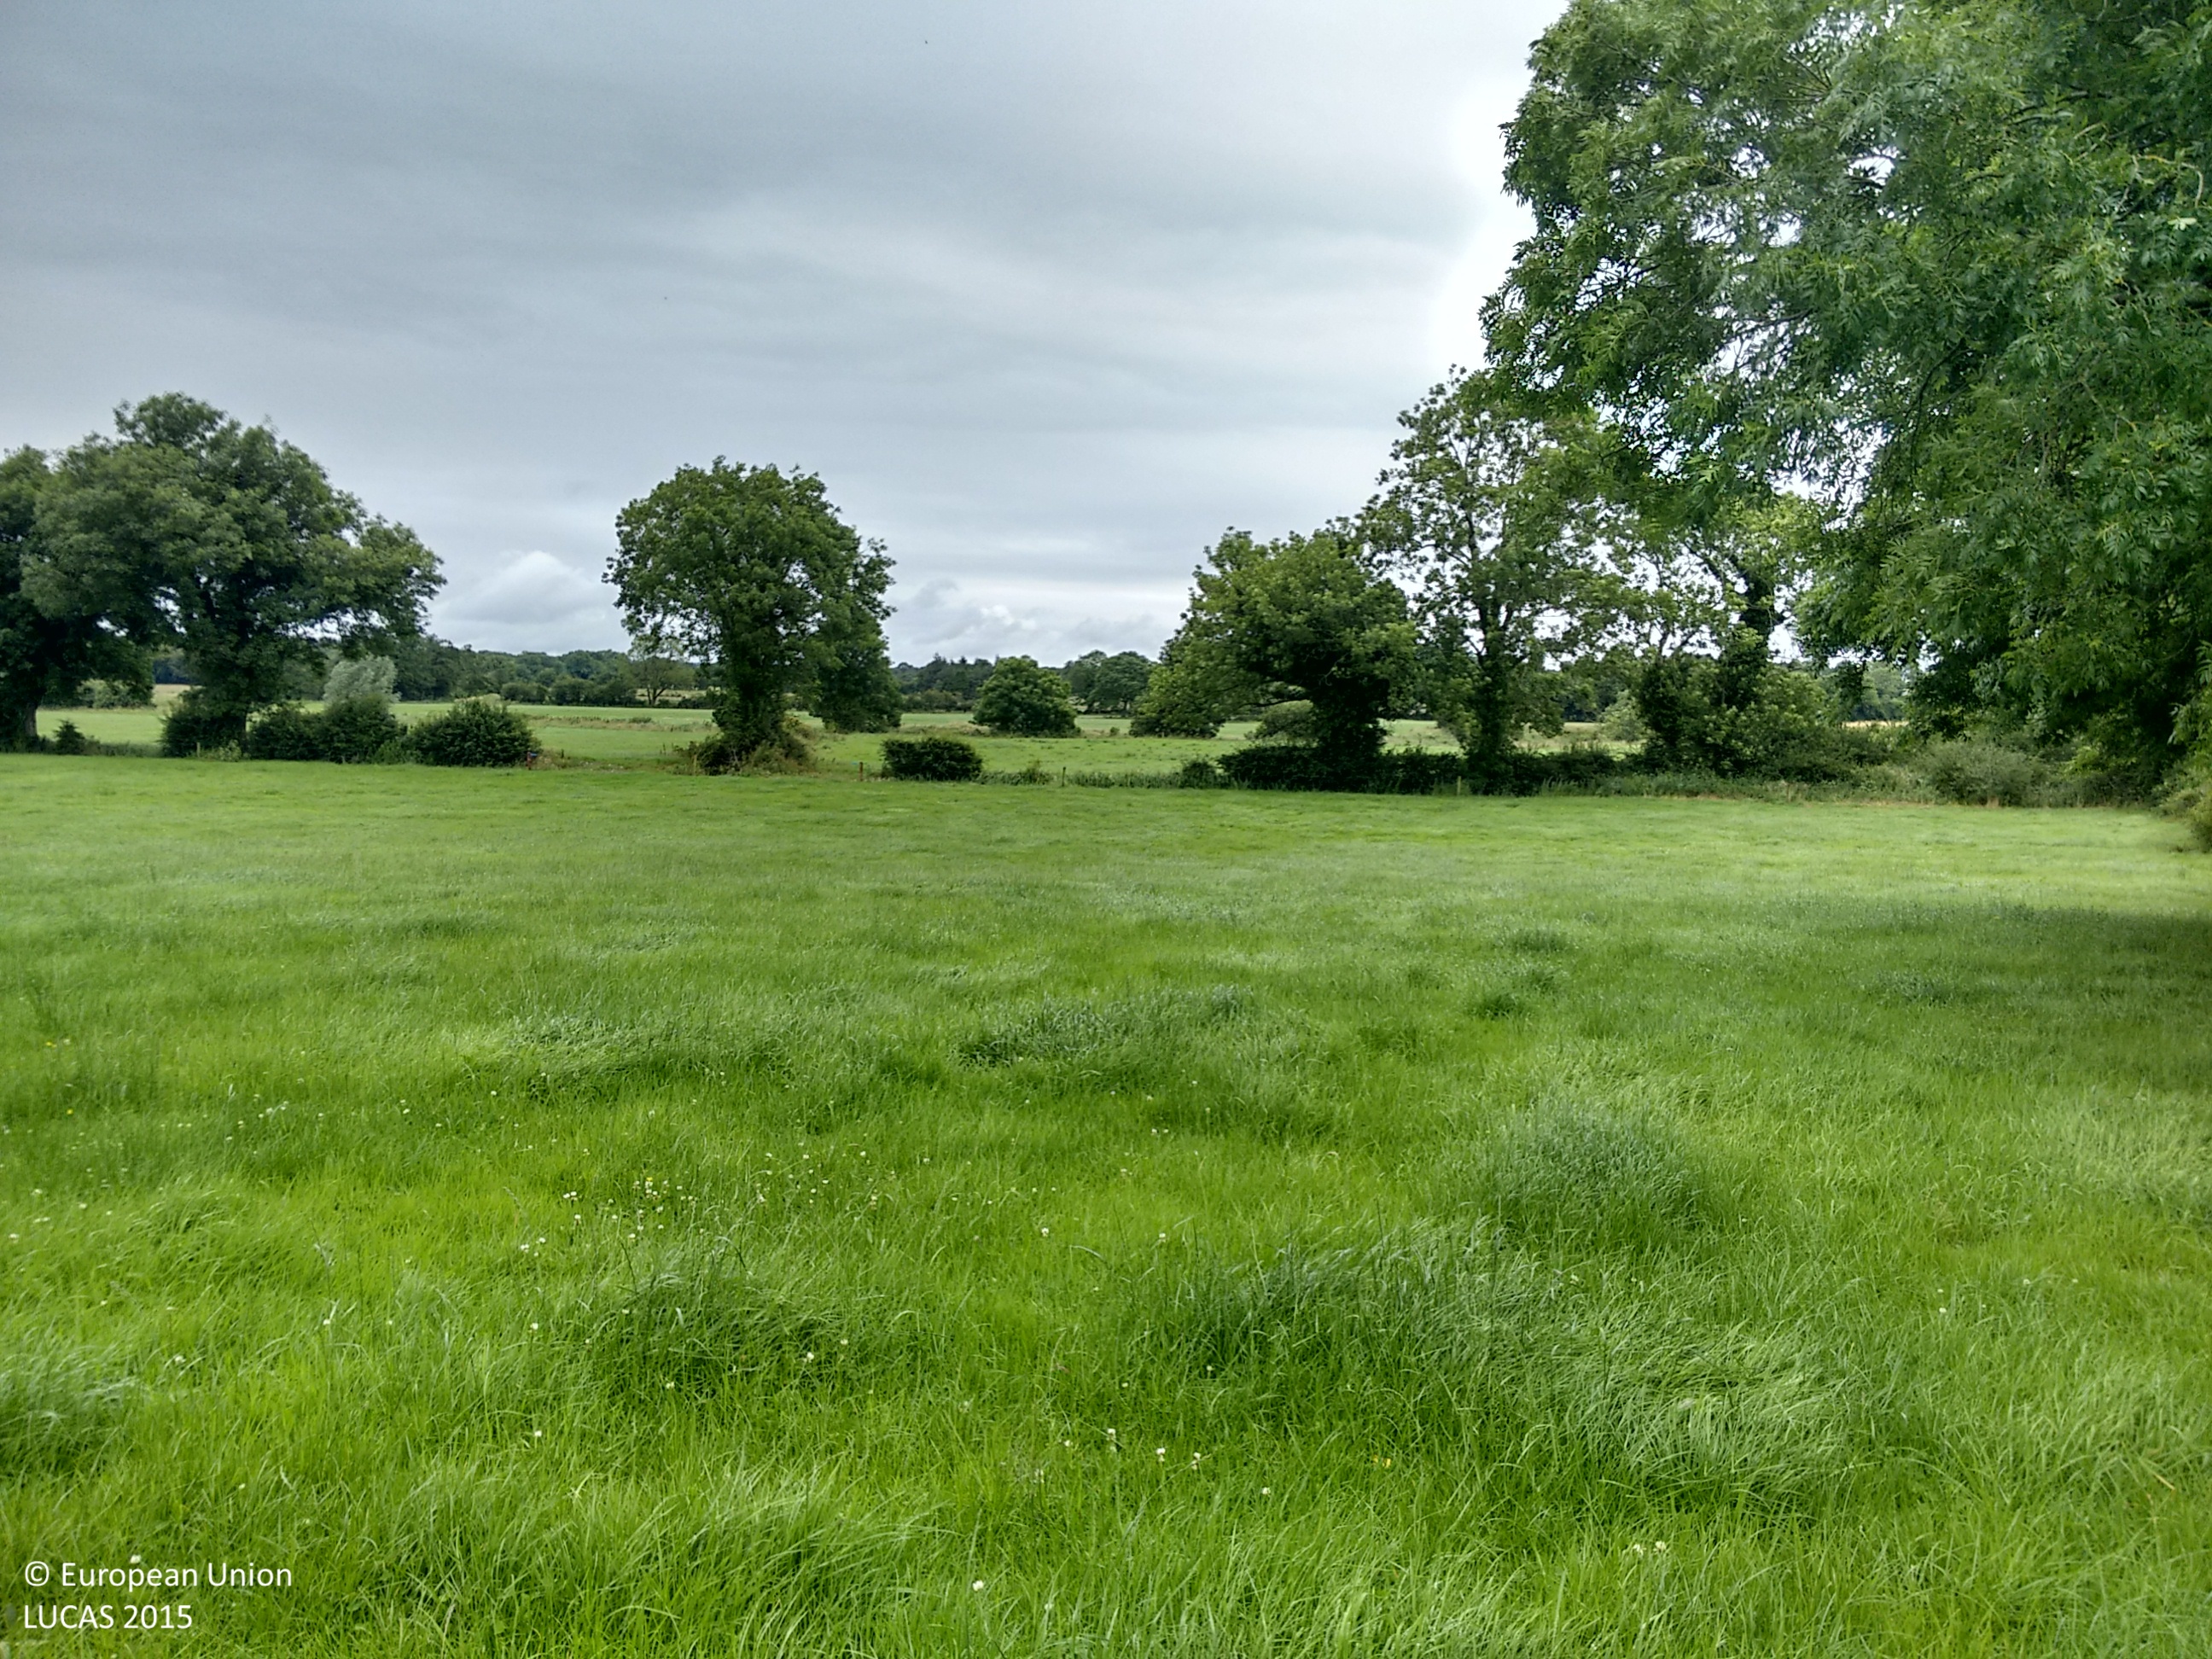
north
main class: Grassland
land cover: Grassland without tree/shrub cover
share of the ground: > 75 %
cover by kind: herbaceous plants 100 %
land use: Agriculture (excluding fallow land and kitchen gardens)
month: July
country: IE
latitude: 53.5763
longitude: -7.6987
